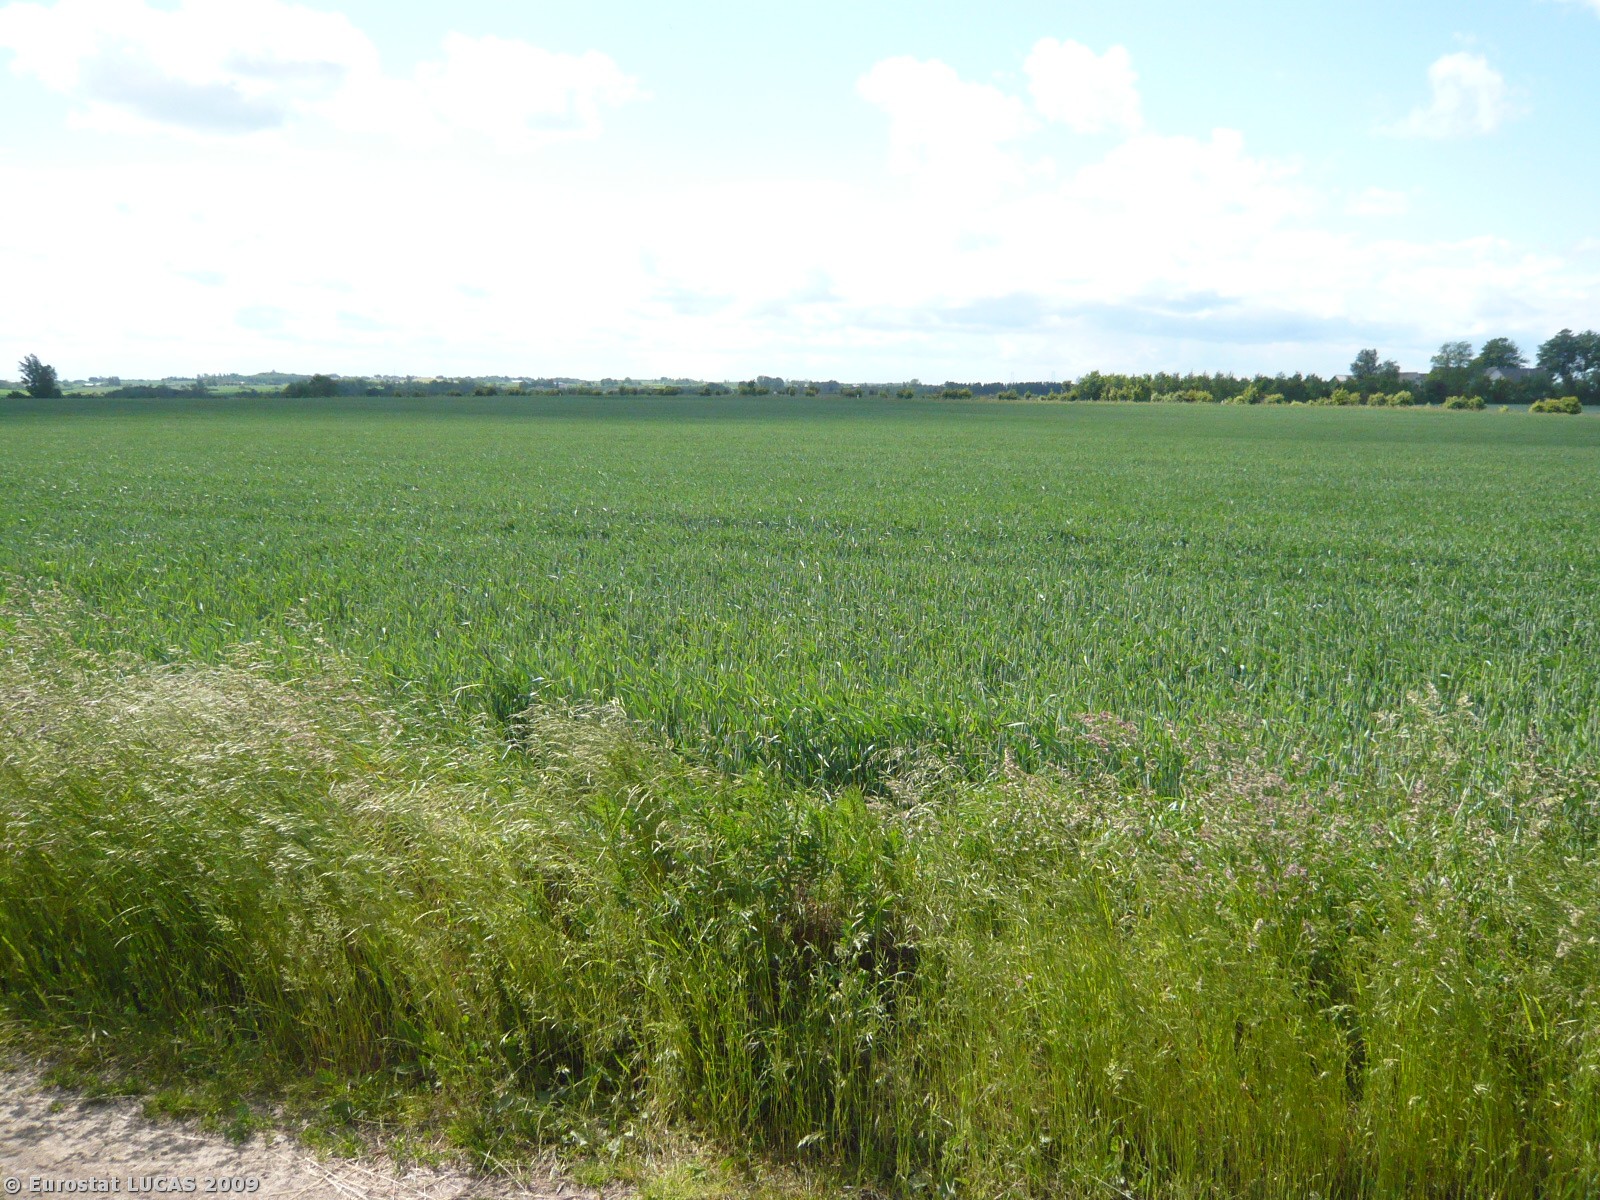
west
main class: Cropland
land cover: Rape and turnip rape
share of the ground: > 75 %
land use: Agriculture (excluding fallow land and kitchen gardens)
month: June
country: DK
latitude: 55.3179
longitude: 11.3383
